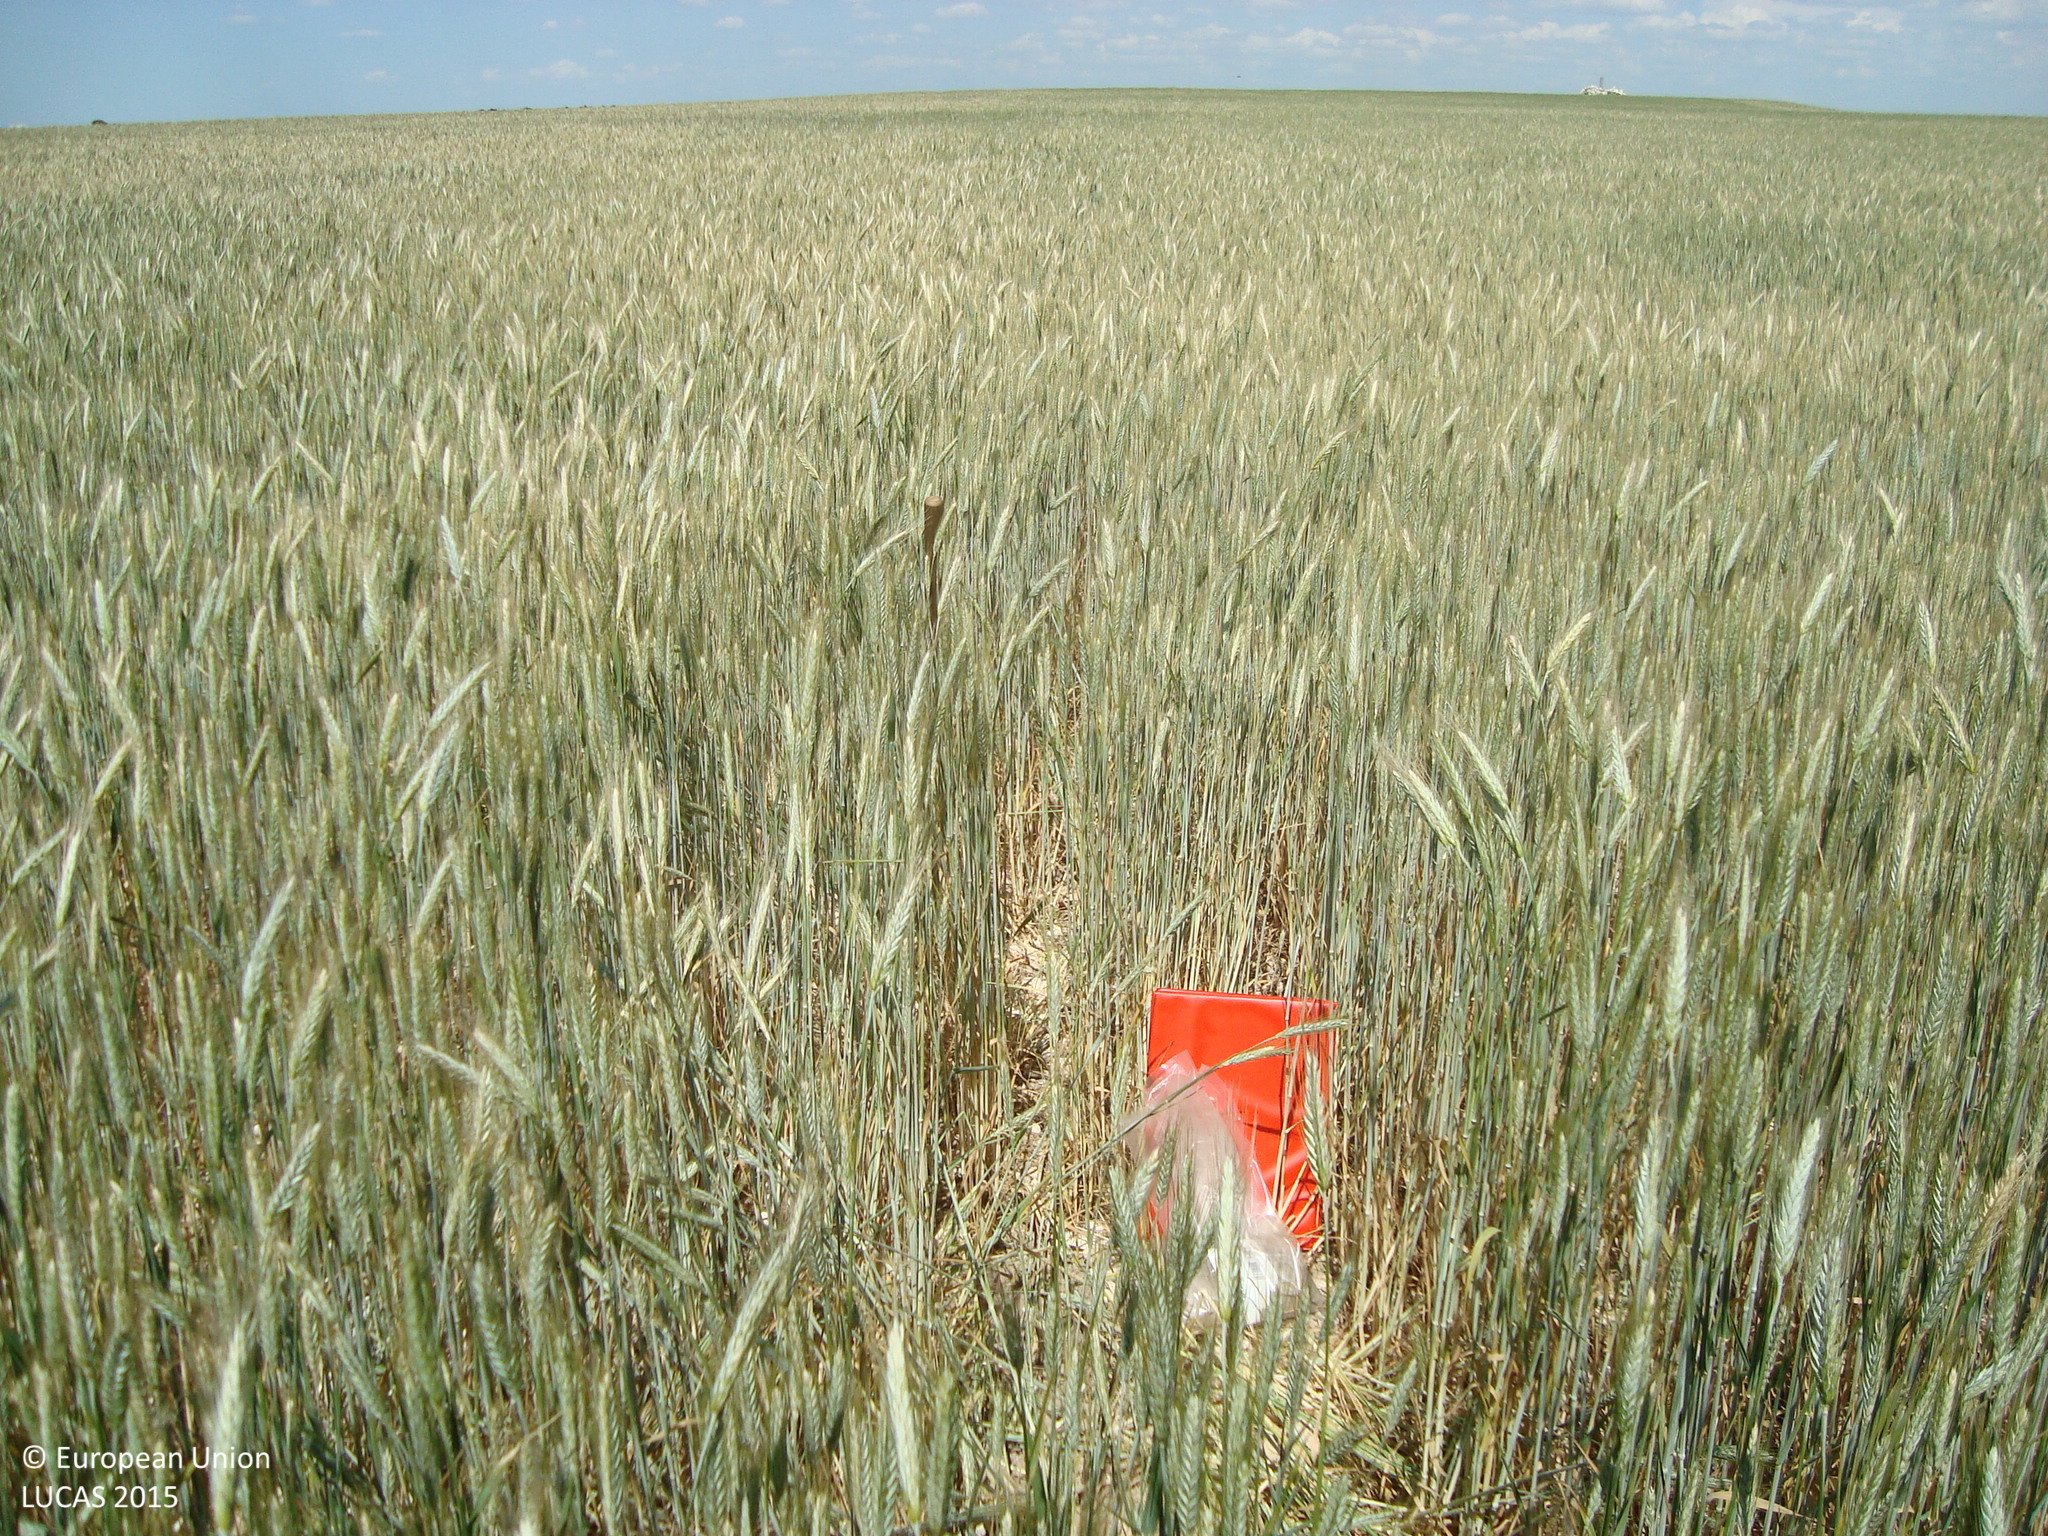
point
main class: Cropland
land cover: Rye
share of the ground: > 75 %
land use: Agriculture (excluding fallow land and kitchen gardens)
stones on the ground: < 10 %
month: May
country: ES
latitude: 41.5483
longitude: -3.9984
